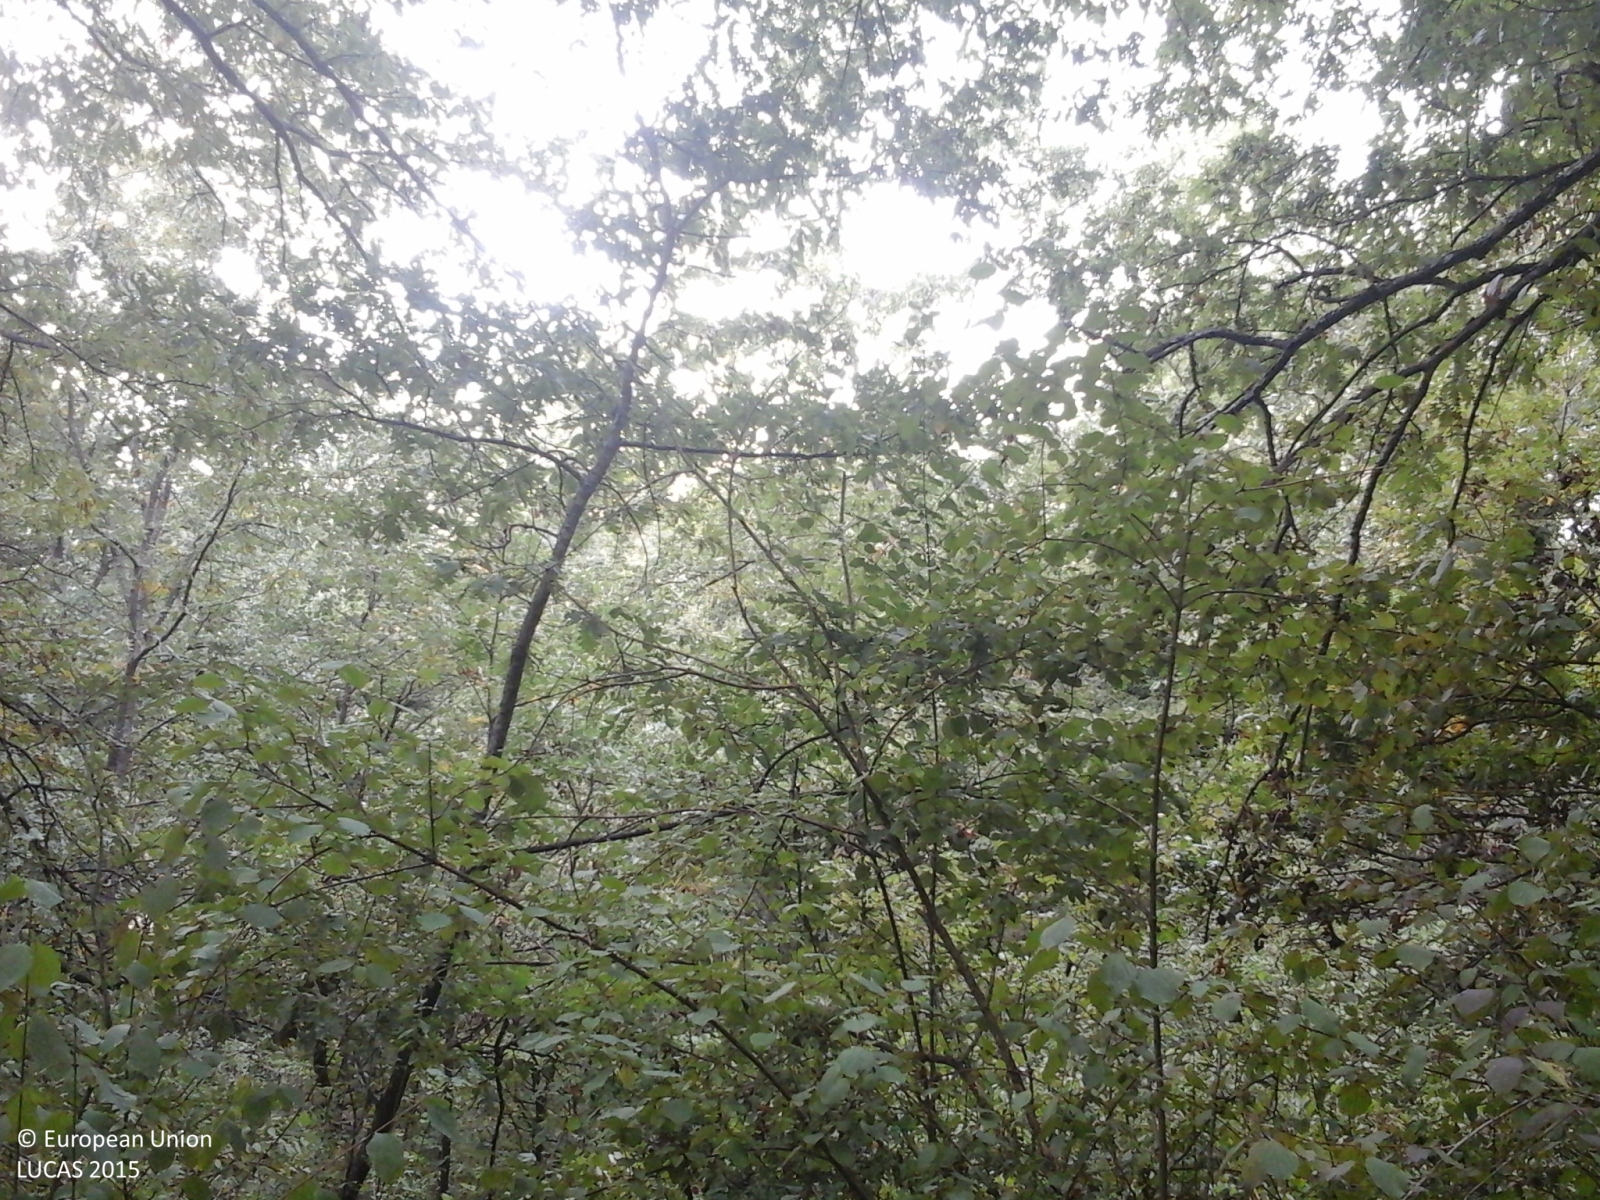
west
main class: Woodland
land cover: Broadleaved woodland
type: thermophilous deciduous forest
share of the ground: > 75 %
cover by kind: broadleaved forest trees 80 %, shrubs 15 %, herbaceous plants 5 %
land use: Forestry
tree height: > 5 m
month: October
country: IT
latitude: 43.2904
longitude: 12.5443
